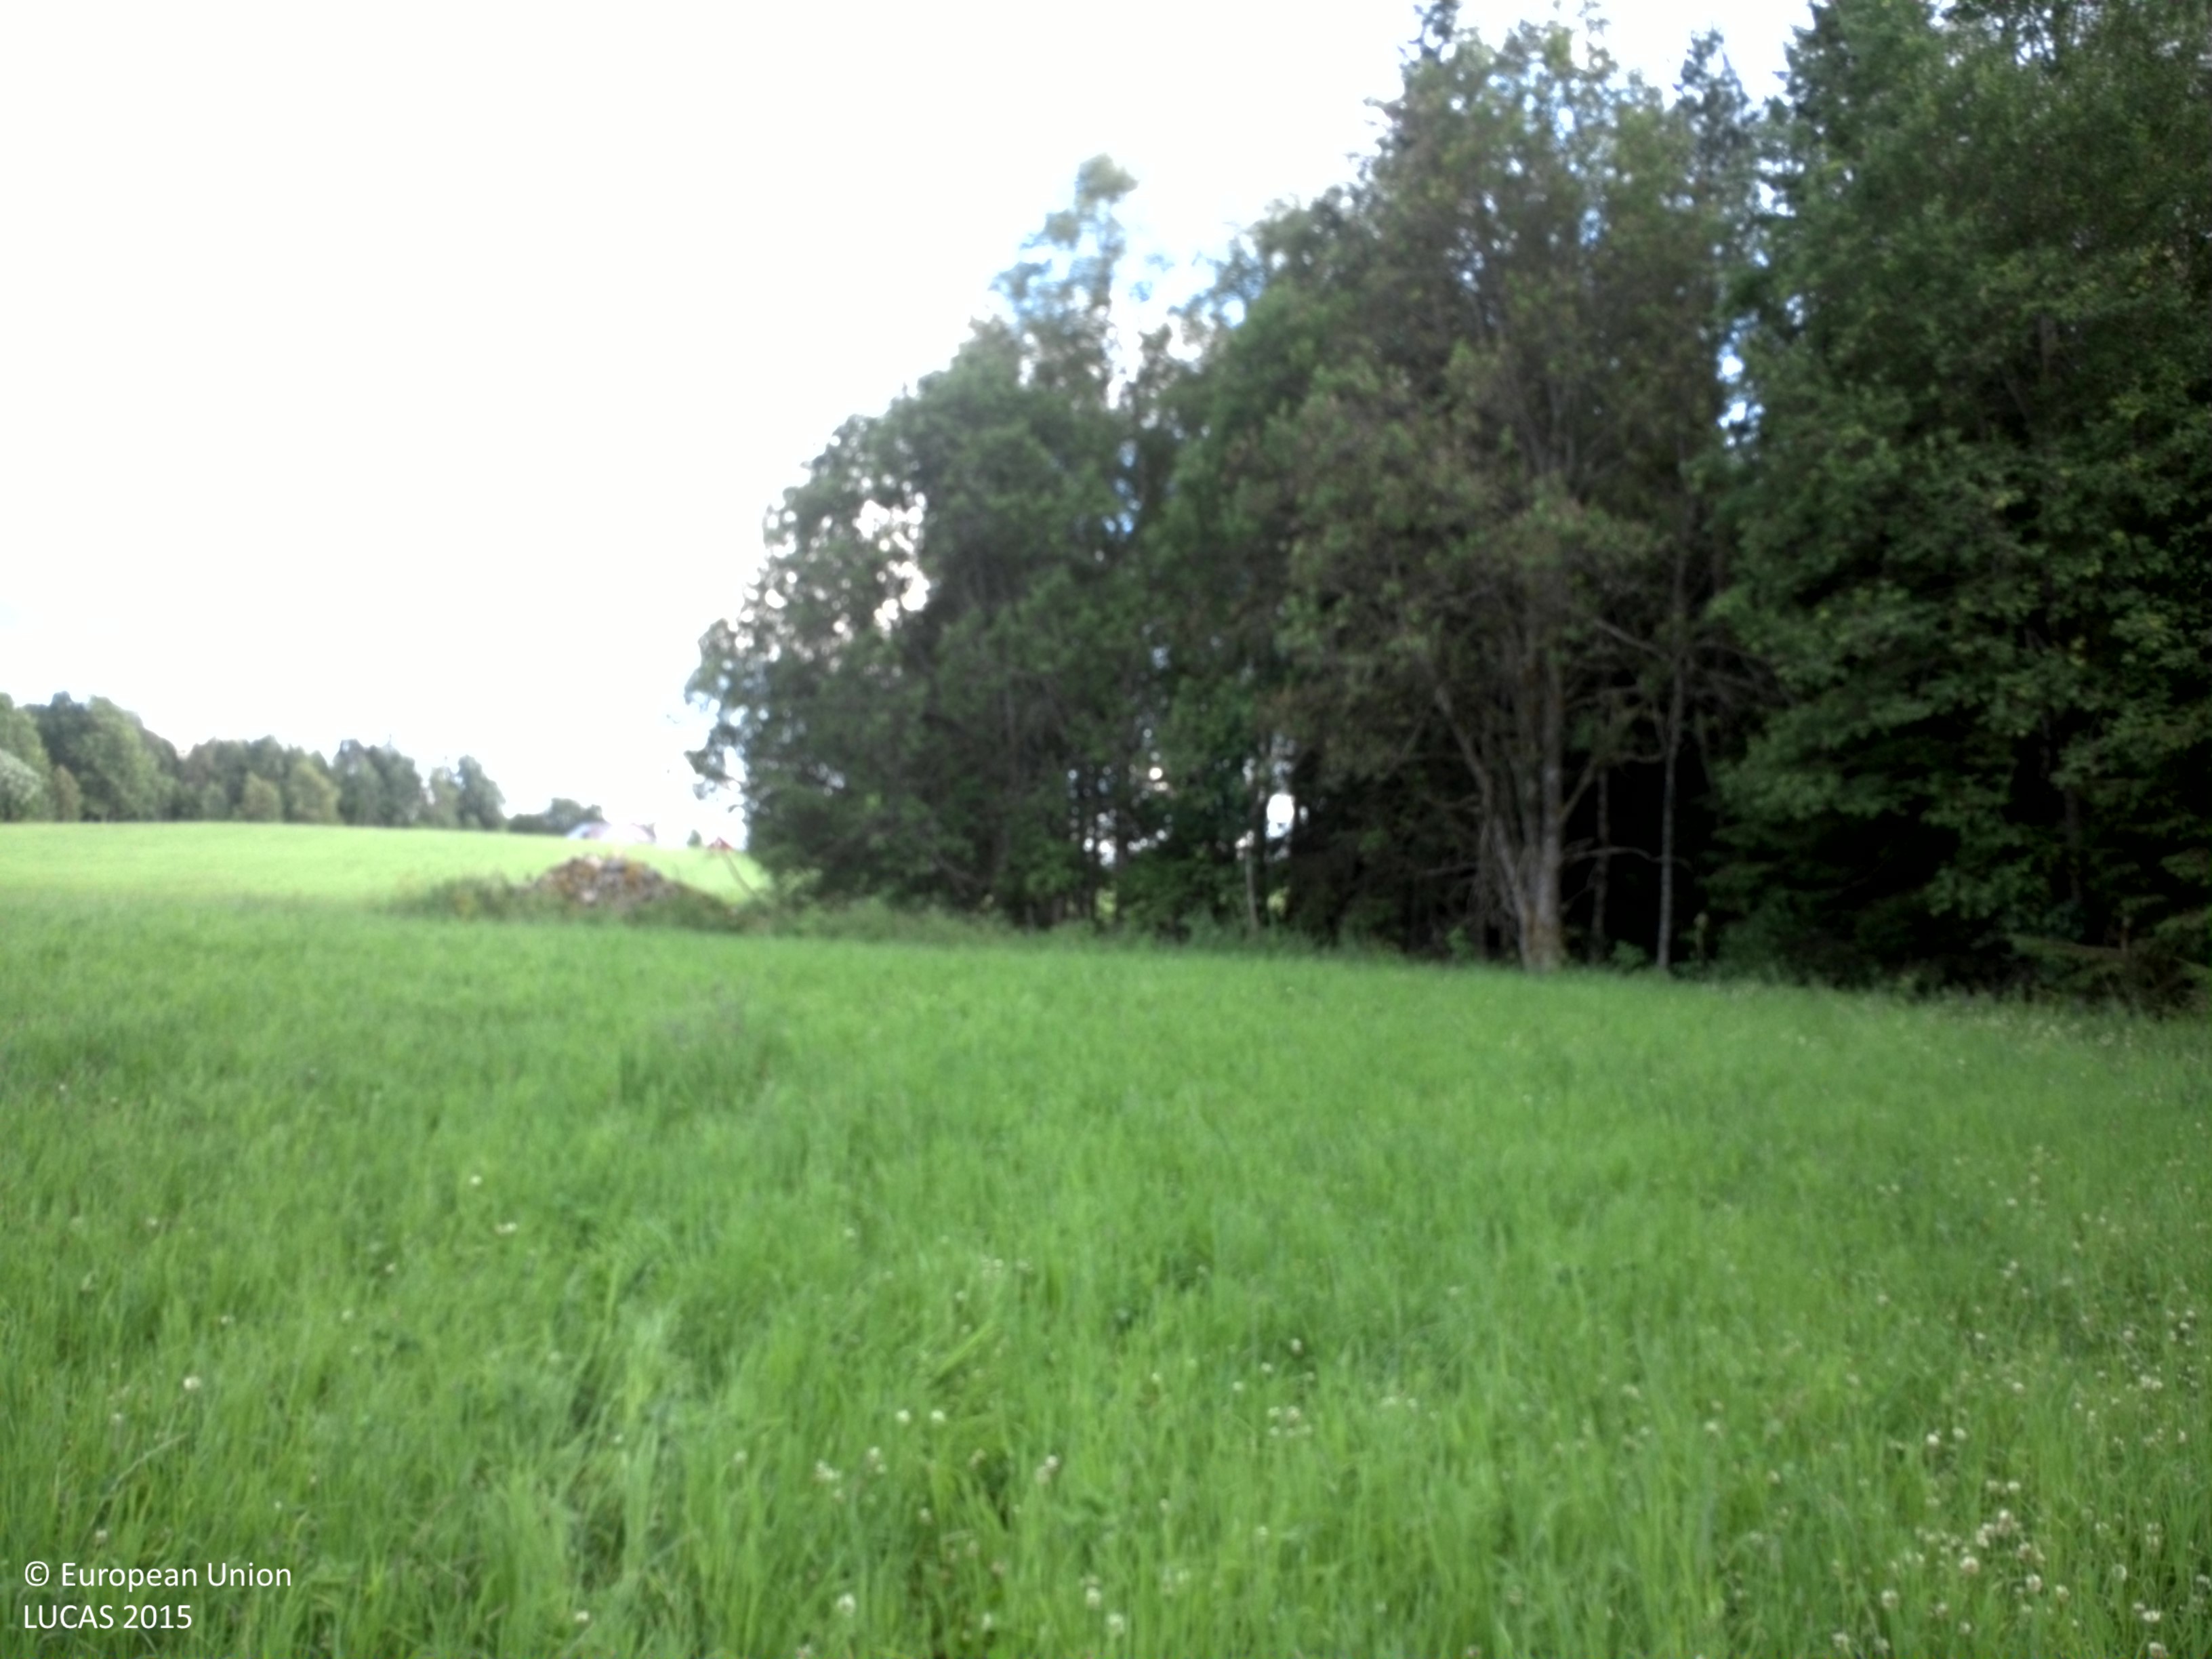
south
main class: Cropland
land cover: Other leguminous and mixtures for fodder
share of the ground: > 75 %
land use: Agriculture (excluding fallow land and kitchen gardens)
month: July
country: SE
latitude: 57.6027
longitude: 14.5305
